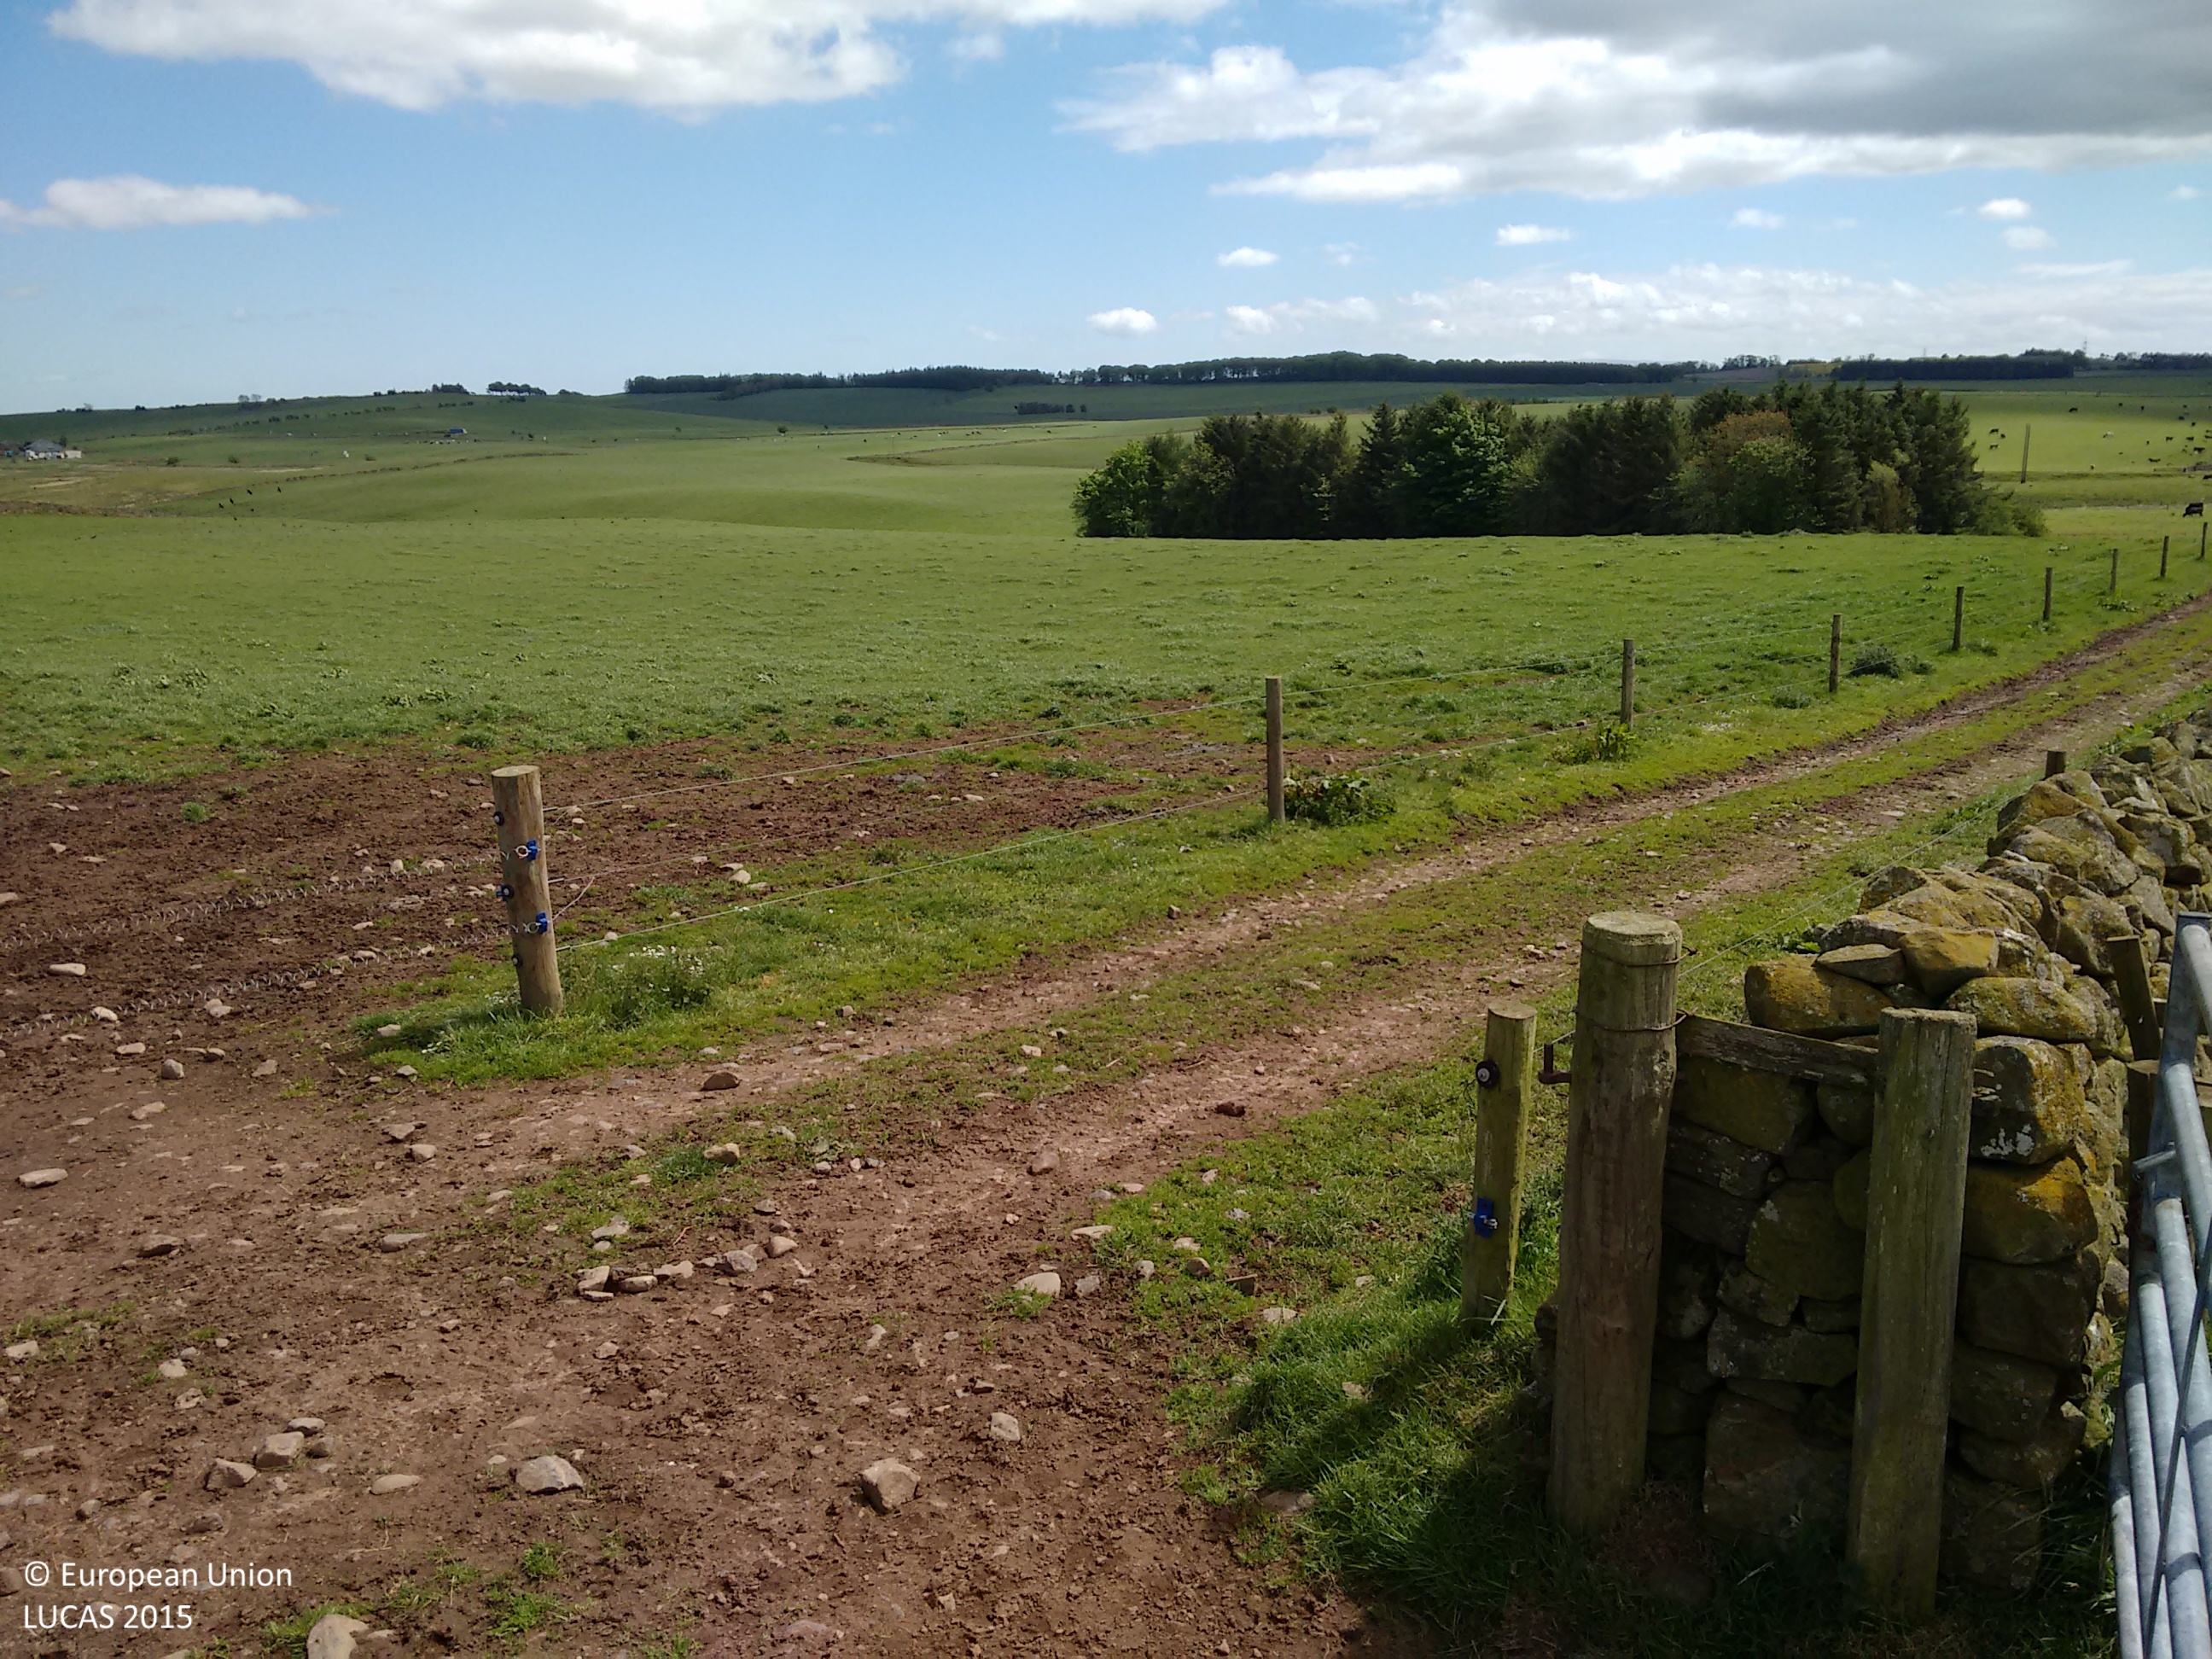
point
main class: Grassland
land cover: Grassland without tree/shrub cover
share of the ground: > 75 %
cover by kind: herbaceous plants 100 %
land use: Agriculture (excluding fallow land and kitchen gardens)
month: June
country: GB
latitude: 55.7023
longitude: -2.4877
